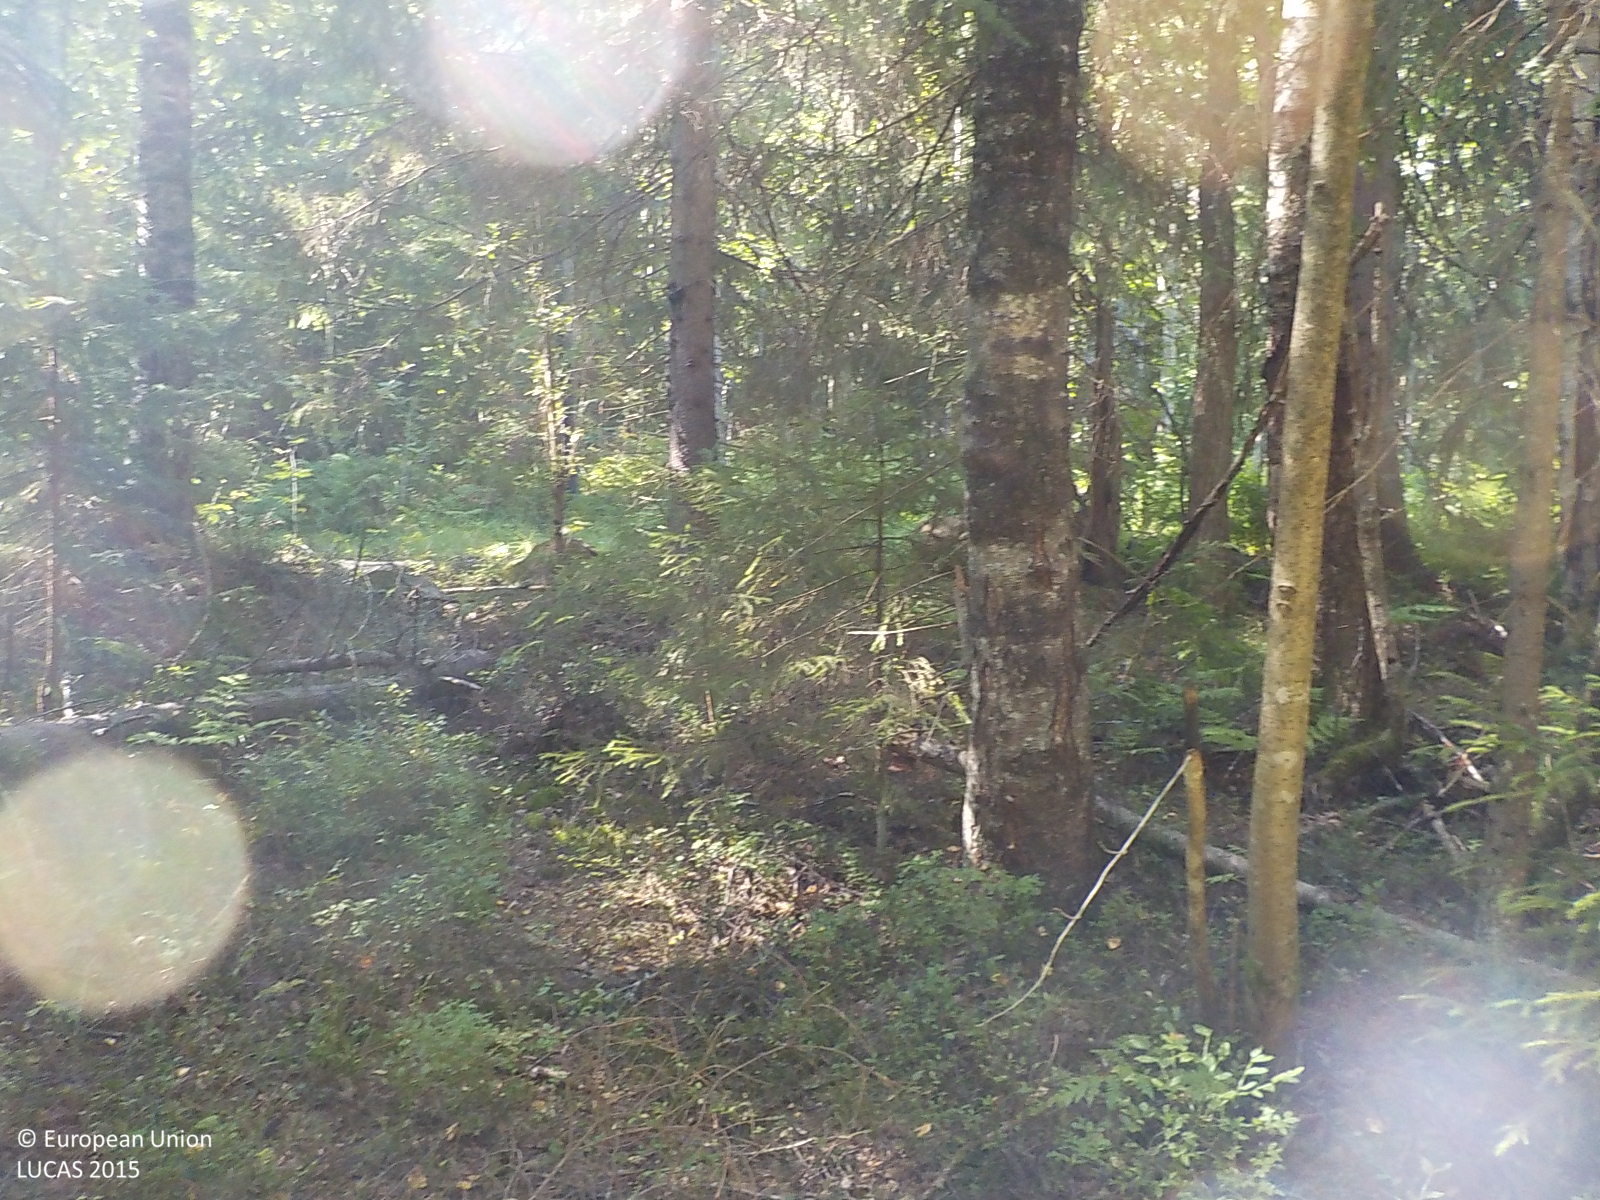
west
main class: Woodland
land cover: Spruce dominated coniferous woodland
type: boreal forest
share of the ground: > 75 %
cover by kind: coniferous forest trees 75 %, herbaceous plants 25 %
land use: Forestry
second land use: Amenities, museums, leisure
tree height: > 5 m
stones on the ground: 10 - 25 %
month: August
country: SE
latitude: 63.3050
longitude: 18.6971
